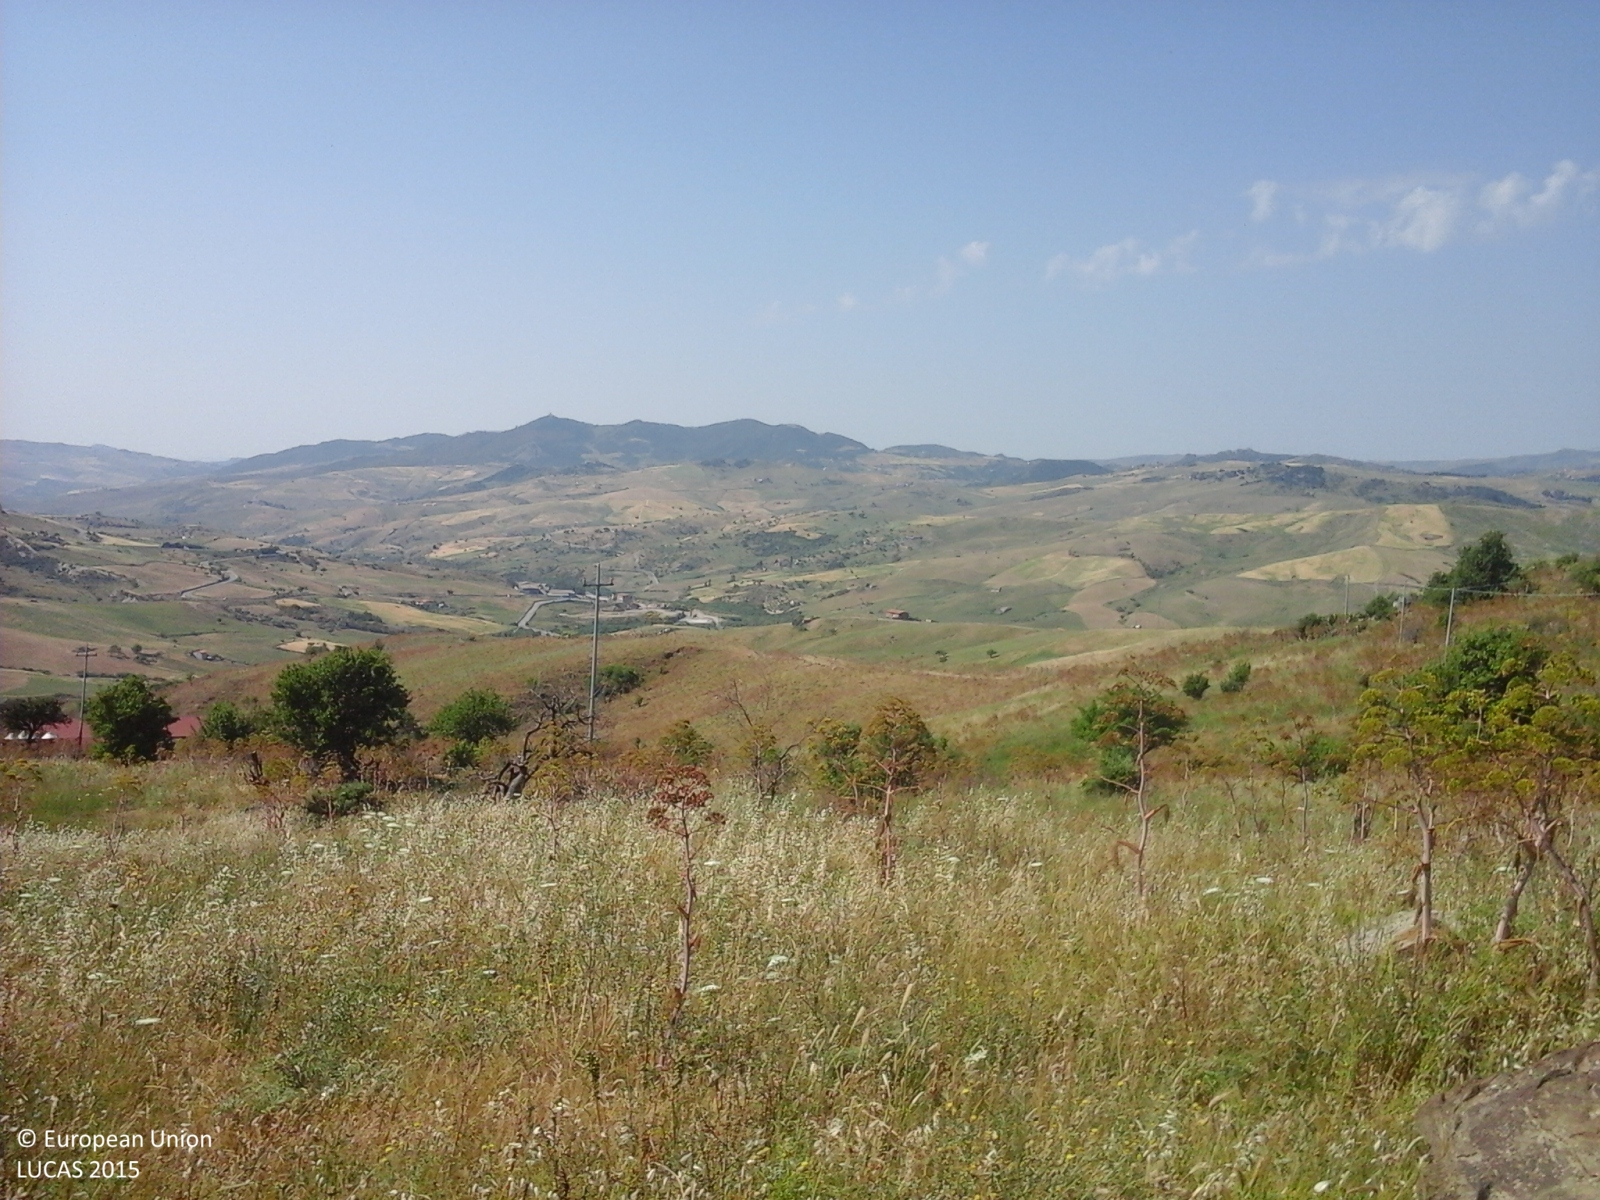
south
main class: Grassland
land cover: Grassland with sparse tree/shrub cover
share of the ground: > 75 %
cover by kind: herbaceous plants 85 %, shrubs 10 %, broadleaved forest trees 5 %
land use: Agriculture (excluding fallow land and kitchen gardens)
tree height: > 5 m
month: June
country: IT
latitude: 37.8238
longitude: 14.4788
